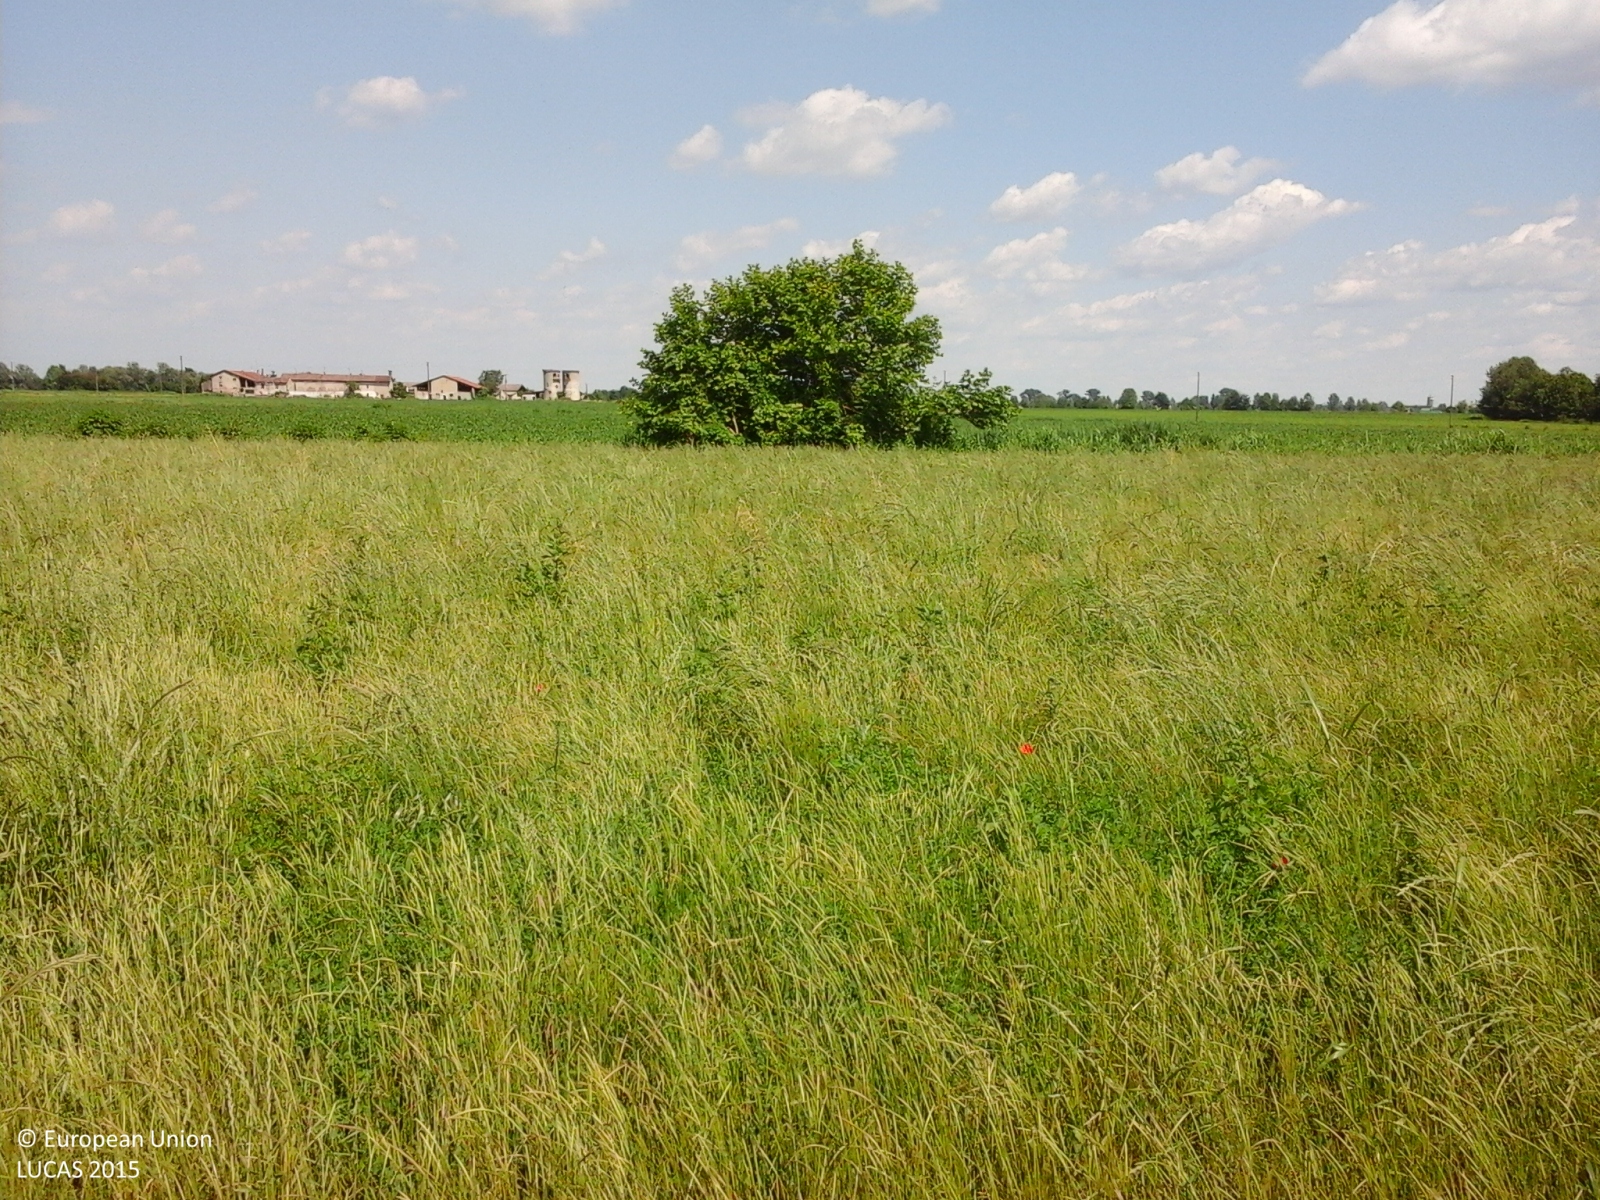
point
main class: Grassland
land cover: Grassland without tree/shrub cover
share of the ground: > 75 %
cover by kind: herbaceous plants 100 %
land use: Agriculture (excluding fallow land and kitchen gardens)
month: May
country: IT
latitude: 45.3419
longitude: 10.2675
